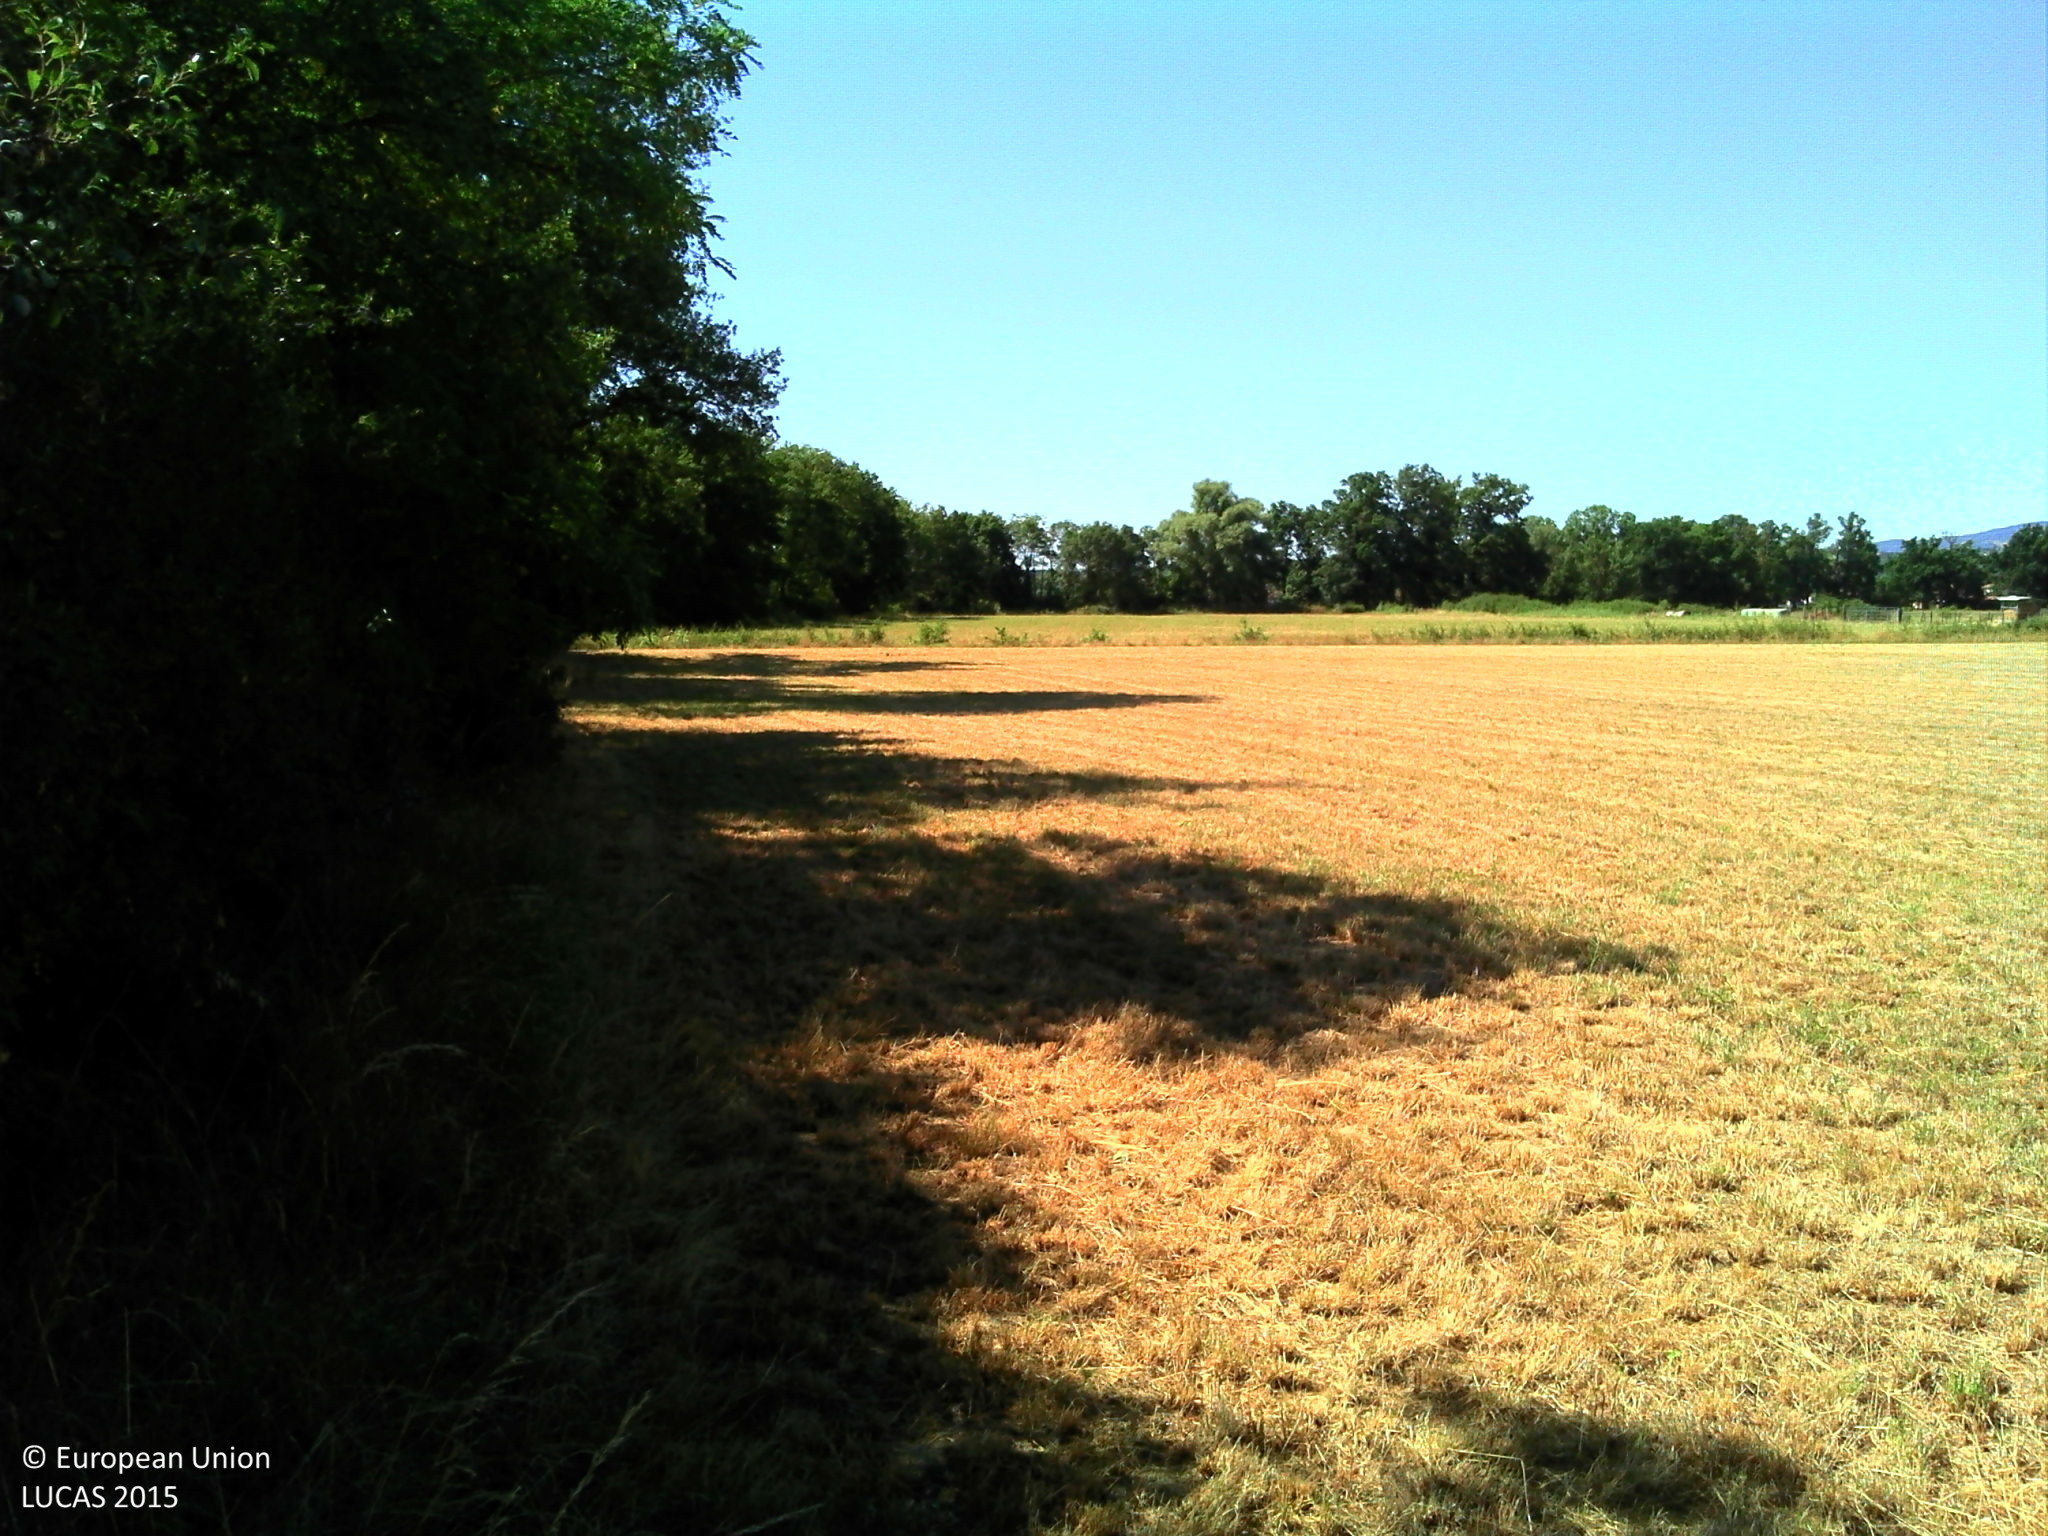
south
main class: Woodland
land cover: Broadleaved woodland
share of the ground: > 75 %
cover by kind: broadleaved forest trees 85 %, shrubs 5 %, herbaceous plants 5 %, lichens and mosses 5 %
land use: Semi-natural and natural areas not in use
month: July
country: FR
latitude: 45.5589
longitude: 4.1484
